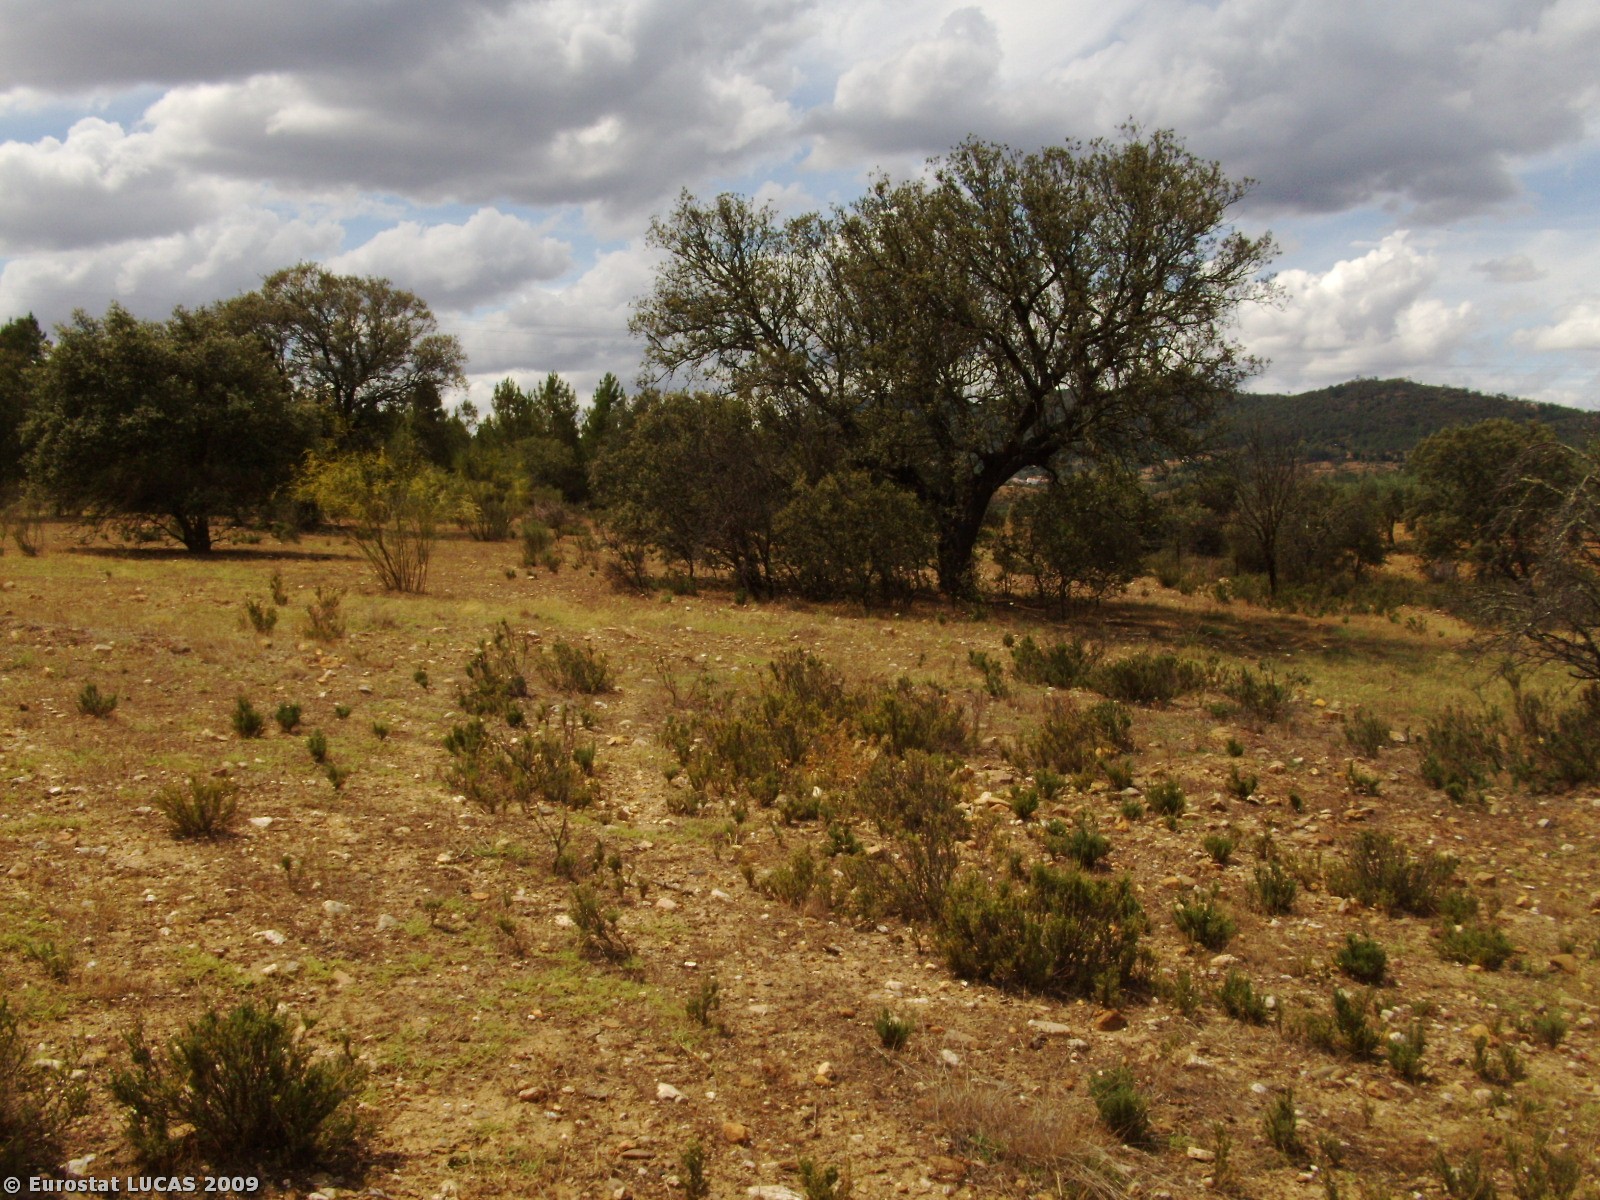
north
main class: Woodland
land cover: Broadleaved woodland
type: broadleaved evergreen forest
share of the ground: 25 - 50 %
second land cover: Spontaneously vegetated surfaces
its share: 10 - 25 %
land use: Forestry
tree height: > 5 m
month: June
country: PT
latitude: 39.9886
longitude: -6.8936
